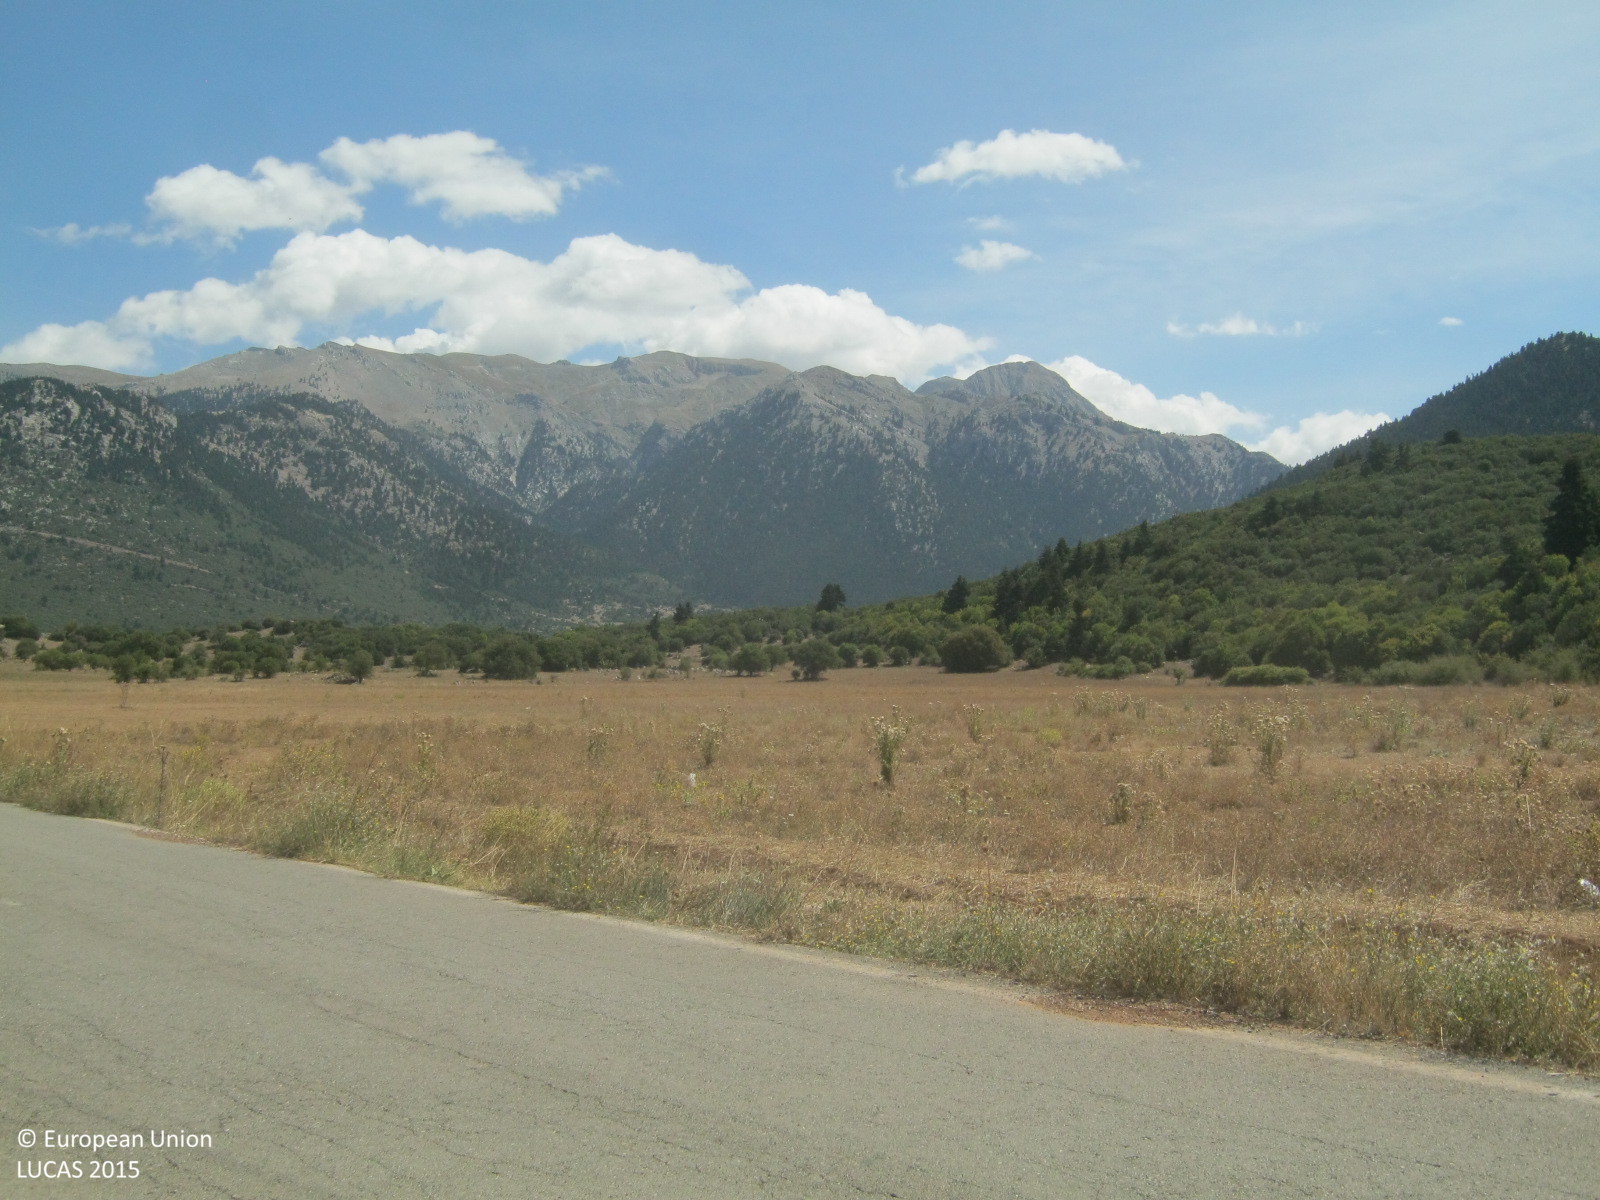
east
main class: Grassland
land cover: Spontaneously vegetated surfaces
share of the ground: > 75 %
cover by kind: herbaceous plants 95 %, unconsolidated bare surface 5 %
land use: Fallow land
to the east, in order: Grass margins; Paved roads, cycling and walking lanes; Spontaneously vegetated surfaces; Barley; Spontaneously vegetated surfaces
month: September
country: GR
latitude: 37.9773
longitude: 22.1136
